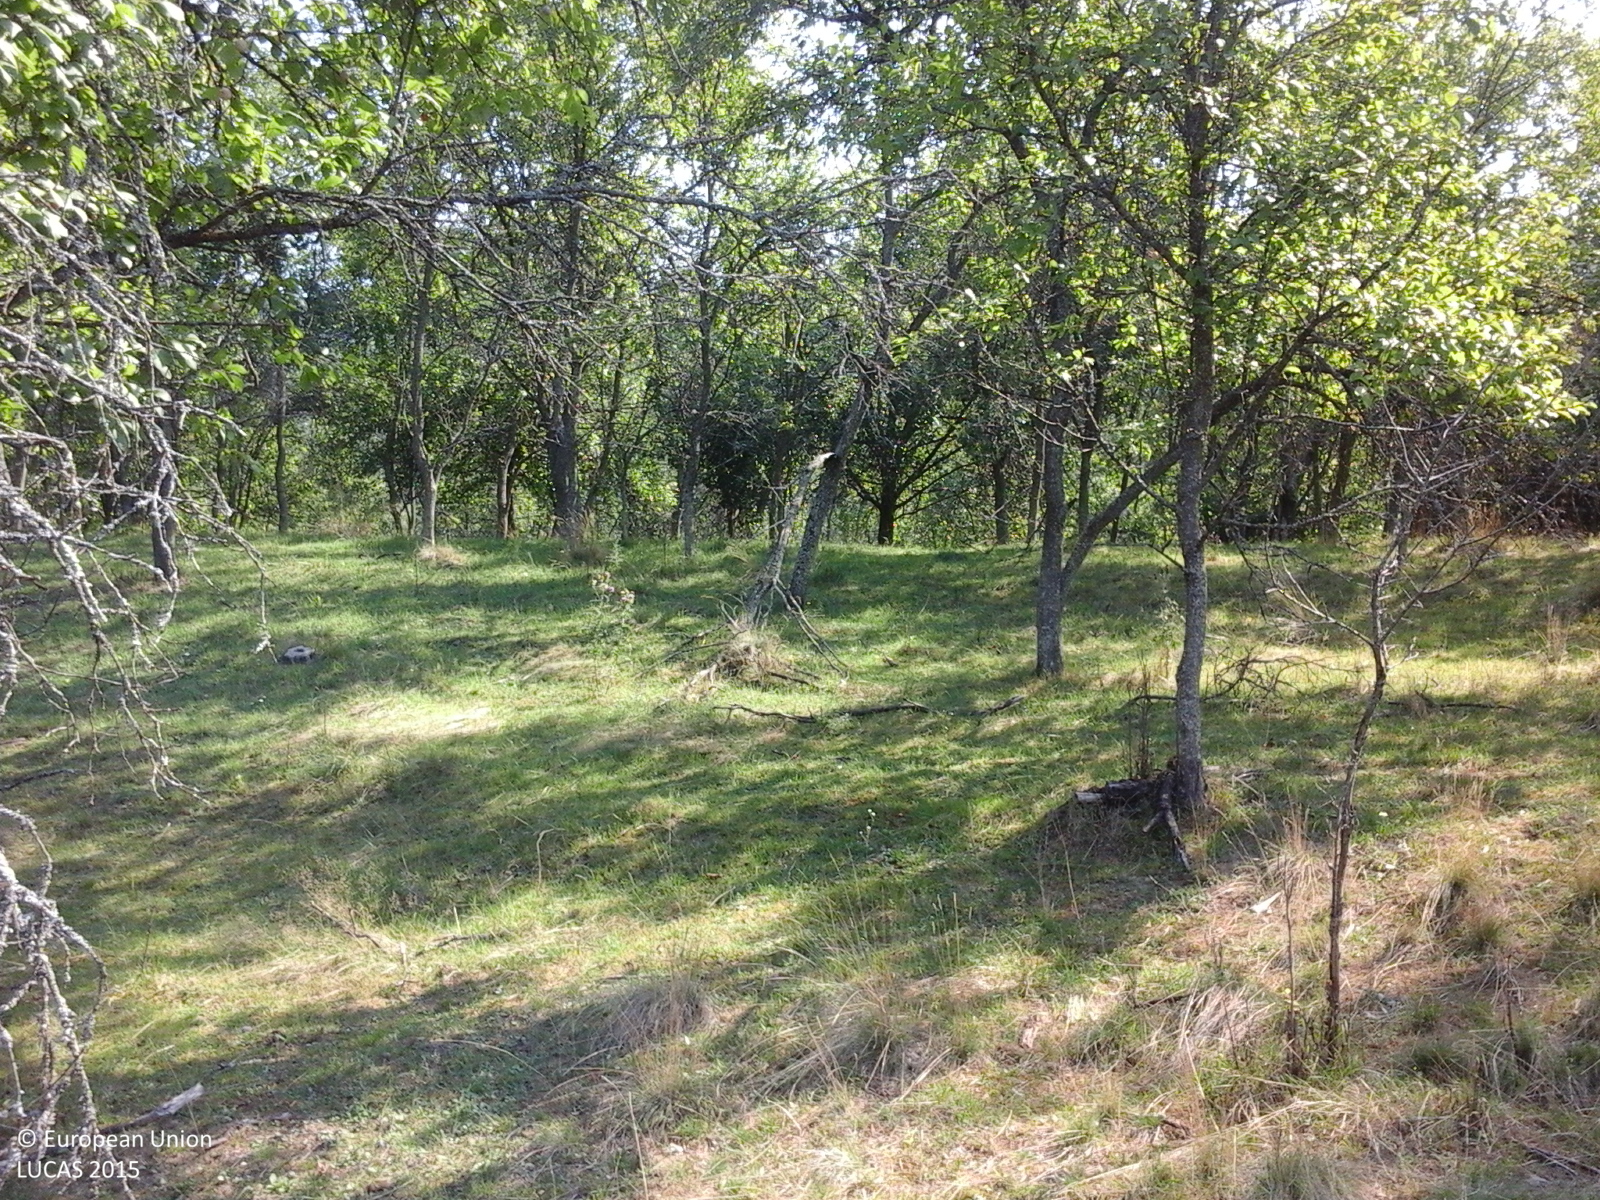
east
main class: Cropland
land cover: Other fruit trees and berries
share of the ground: > 75 %
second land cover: Grassland without tree/shrub cover
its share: 50 - 75 %
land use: Agriculture (excluding fallow land and kitchen gardens)
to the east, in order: Other fruit trees and berries; Grassland without tree/shrub cover; Artificial constructions in urban areas; Grassland without tree/shrub cover; Apple fruit; Fences; Grassland without tree/shrub cover; Permanent crops (only in case pi)
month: August
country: RO
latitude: 46.1512
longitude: 22.8865
